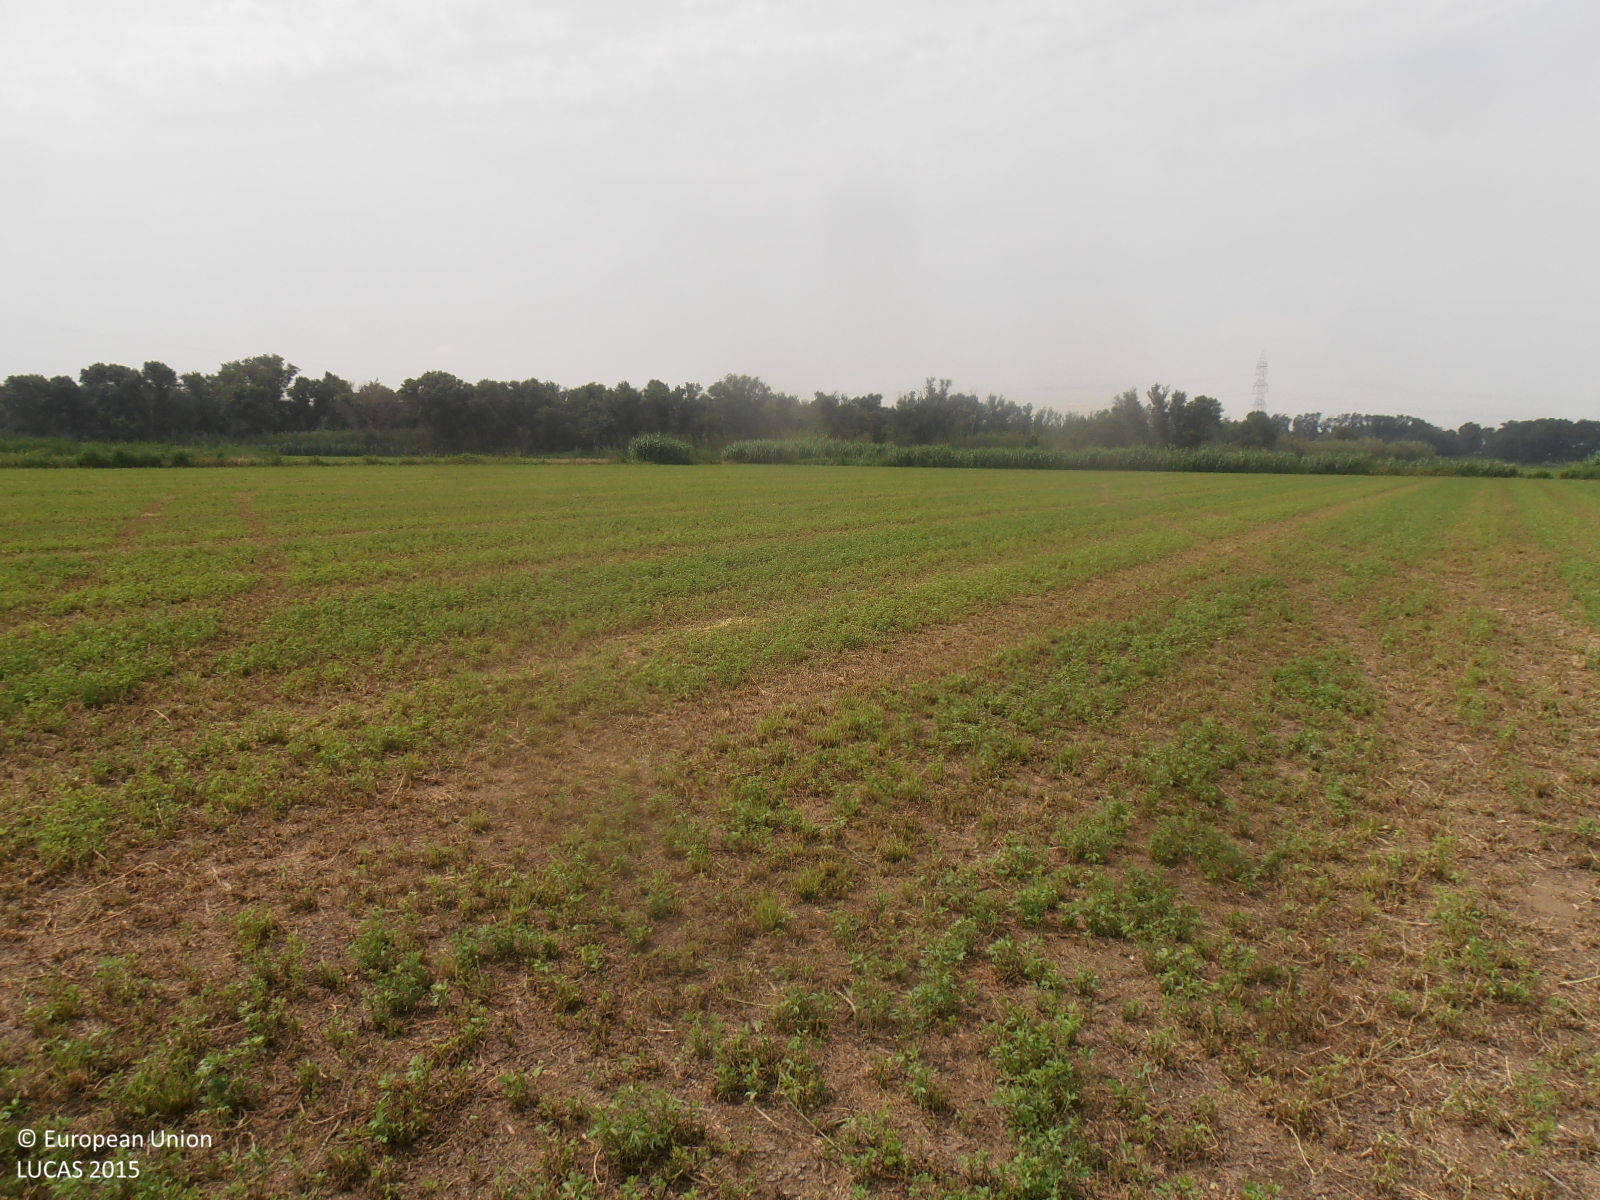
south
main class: Cropland
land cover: Lucerne
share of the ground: > 75 %
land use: Agriculture (excluding fallow land and kitchen gardens)
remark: Harvested field
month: June
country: ES
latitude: 41.7462
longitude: -0.8086
